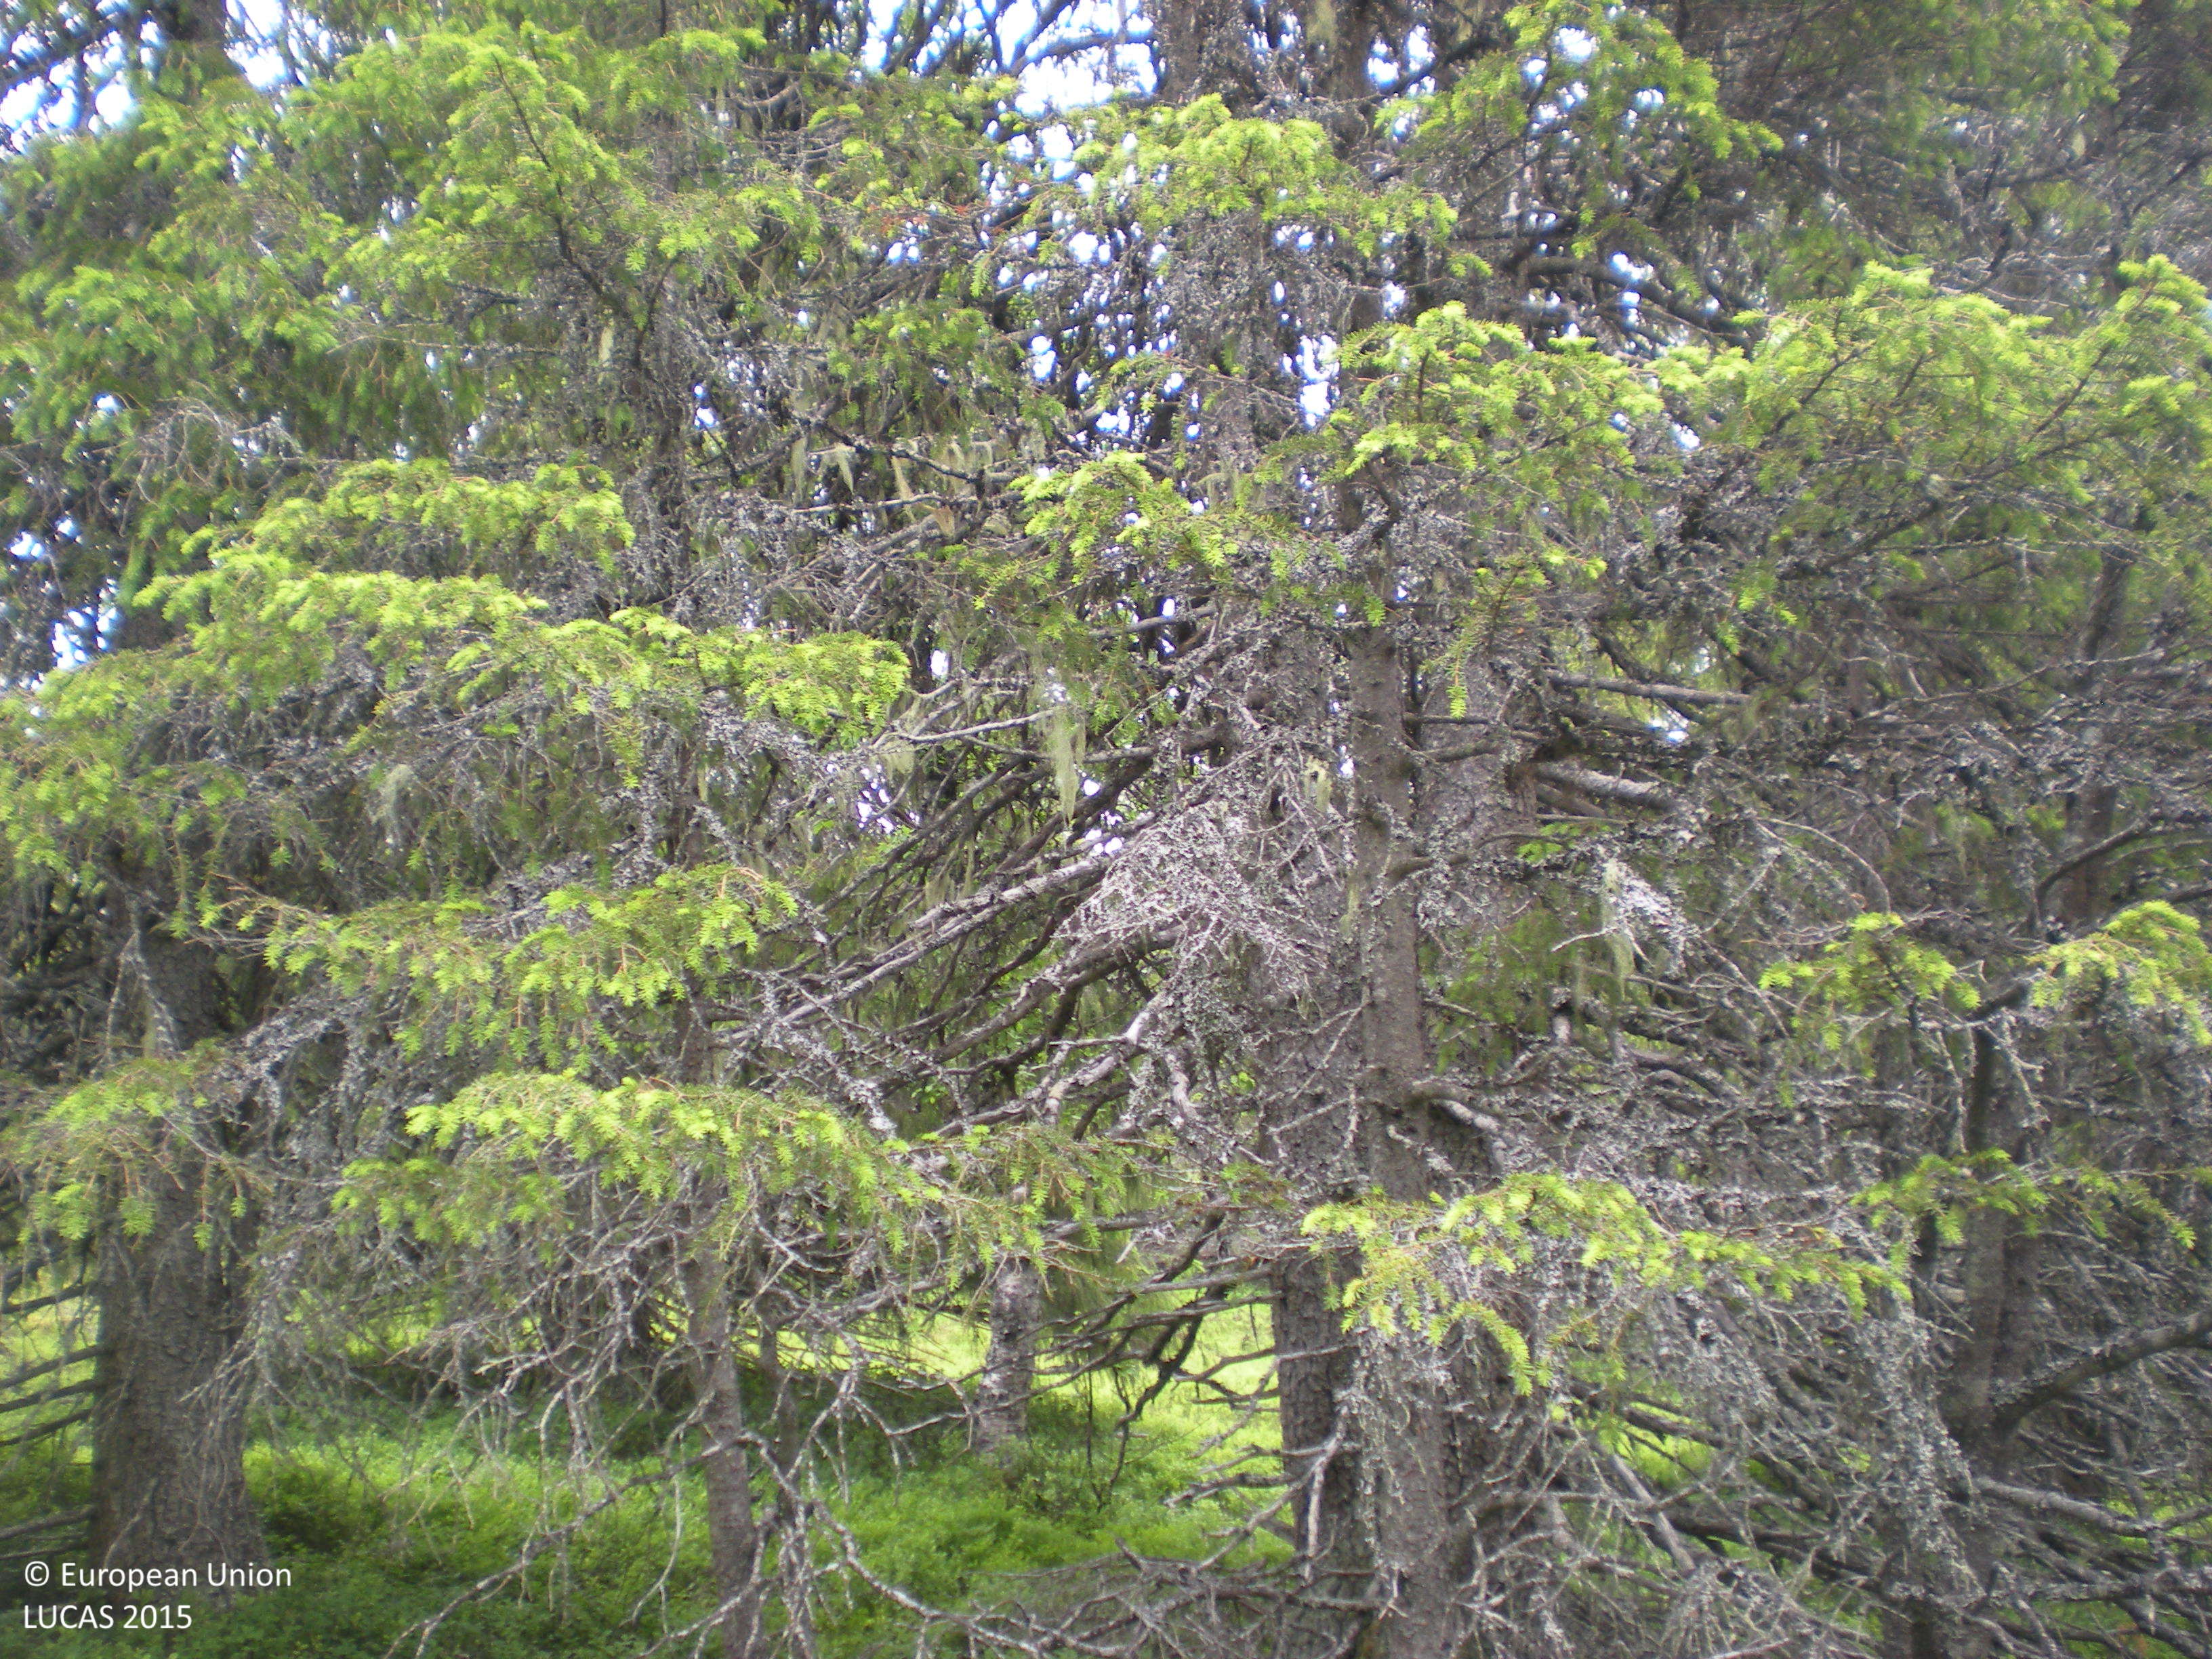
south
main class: Woodland
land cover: Spruce dominated mixed woodland
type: boreal forest
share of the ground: 50 - 75 %
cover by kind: coniferous forest trees 50 %, broadleaved forest trees 20 %, shrubs 20 %, herbaceous plants 5 %, lichens and mosses 5 %
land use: Forestry
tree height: > 5 m
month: July
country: SE
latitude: 65.9297
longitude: 18.2399
